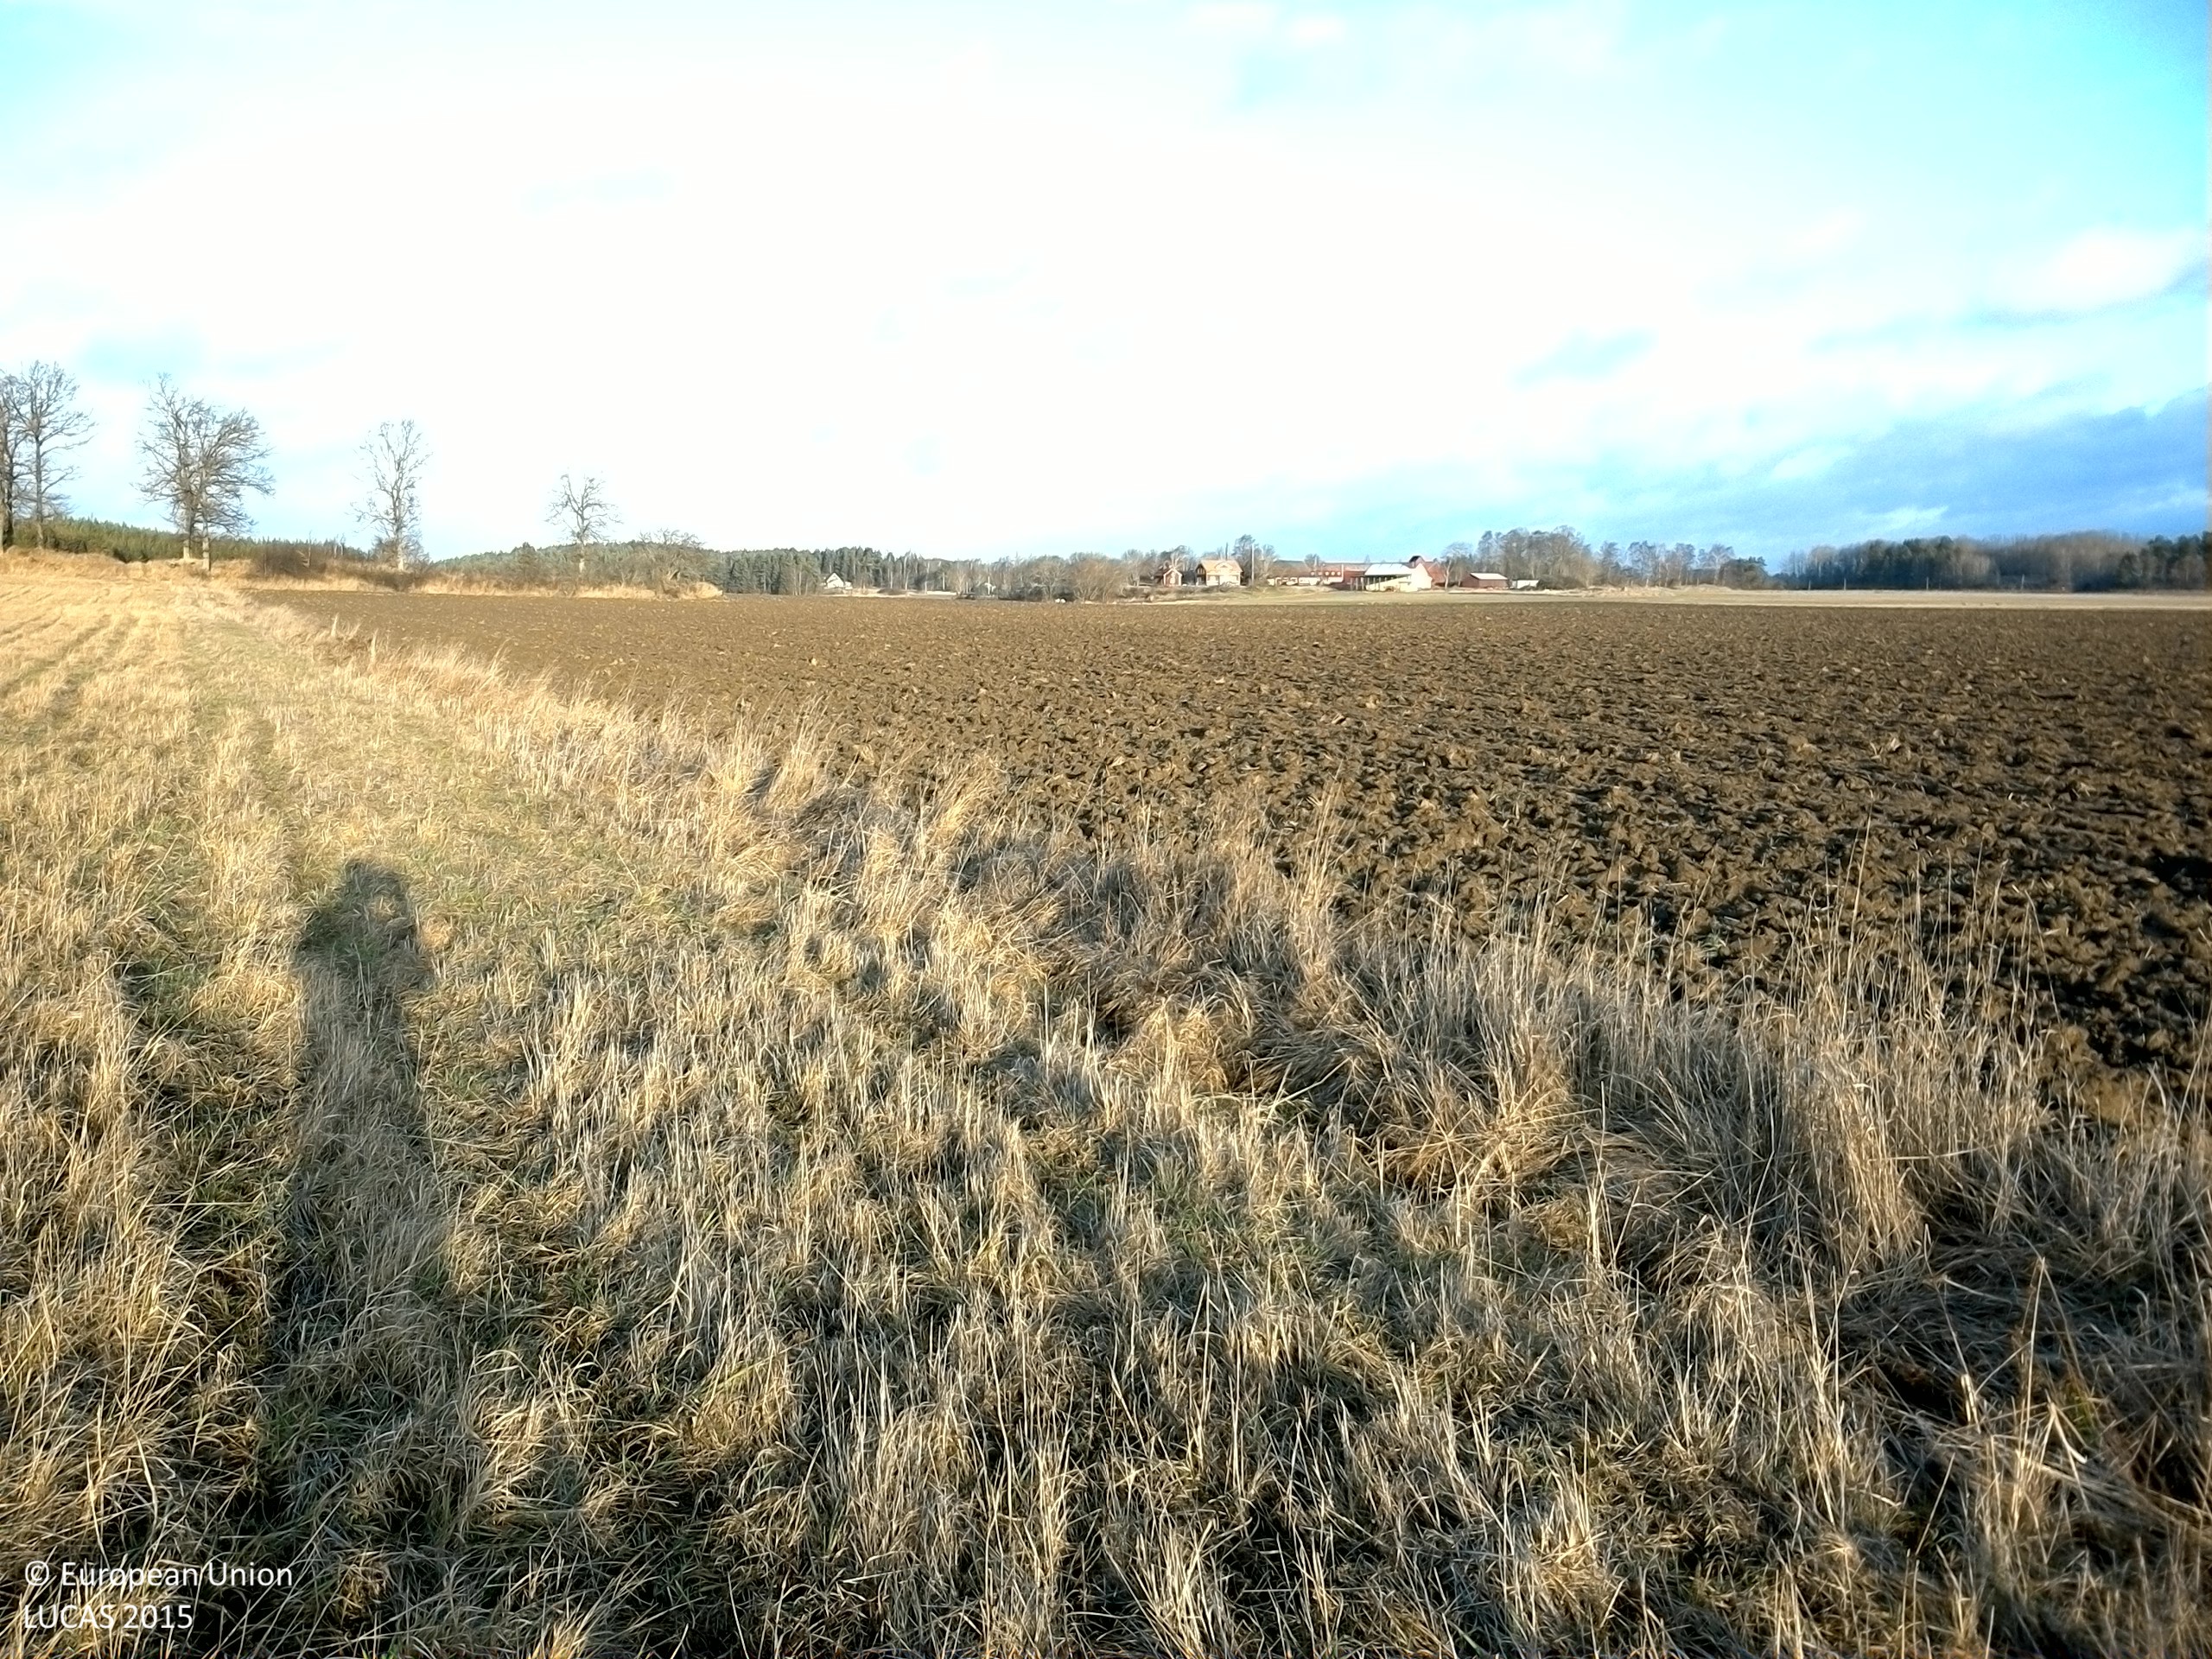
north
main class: Grassland
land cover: Grassland without tree/shrub cover
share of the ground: > 75 %
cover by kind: herbaceous plants 100 %
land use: Agriculture (excluding fallow land and kitchen gardens)
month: December
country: SE
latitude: 59.3786
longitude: 16.9112
